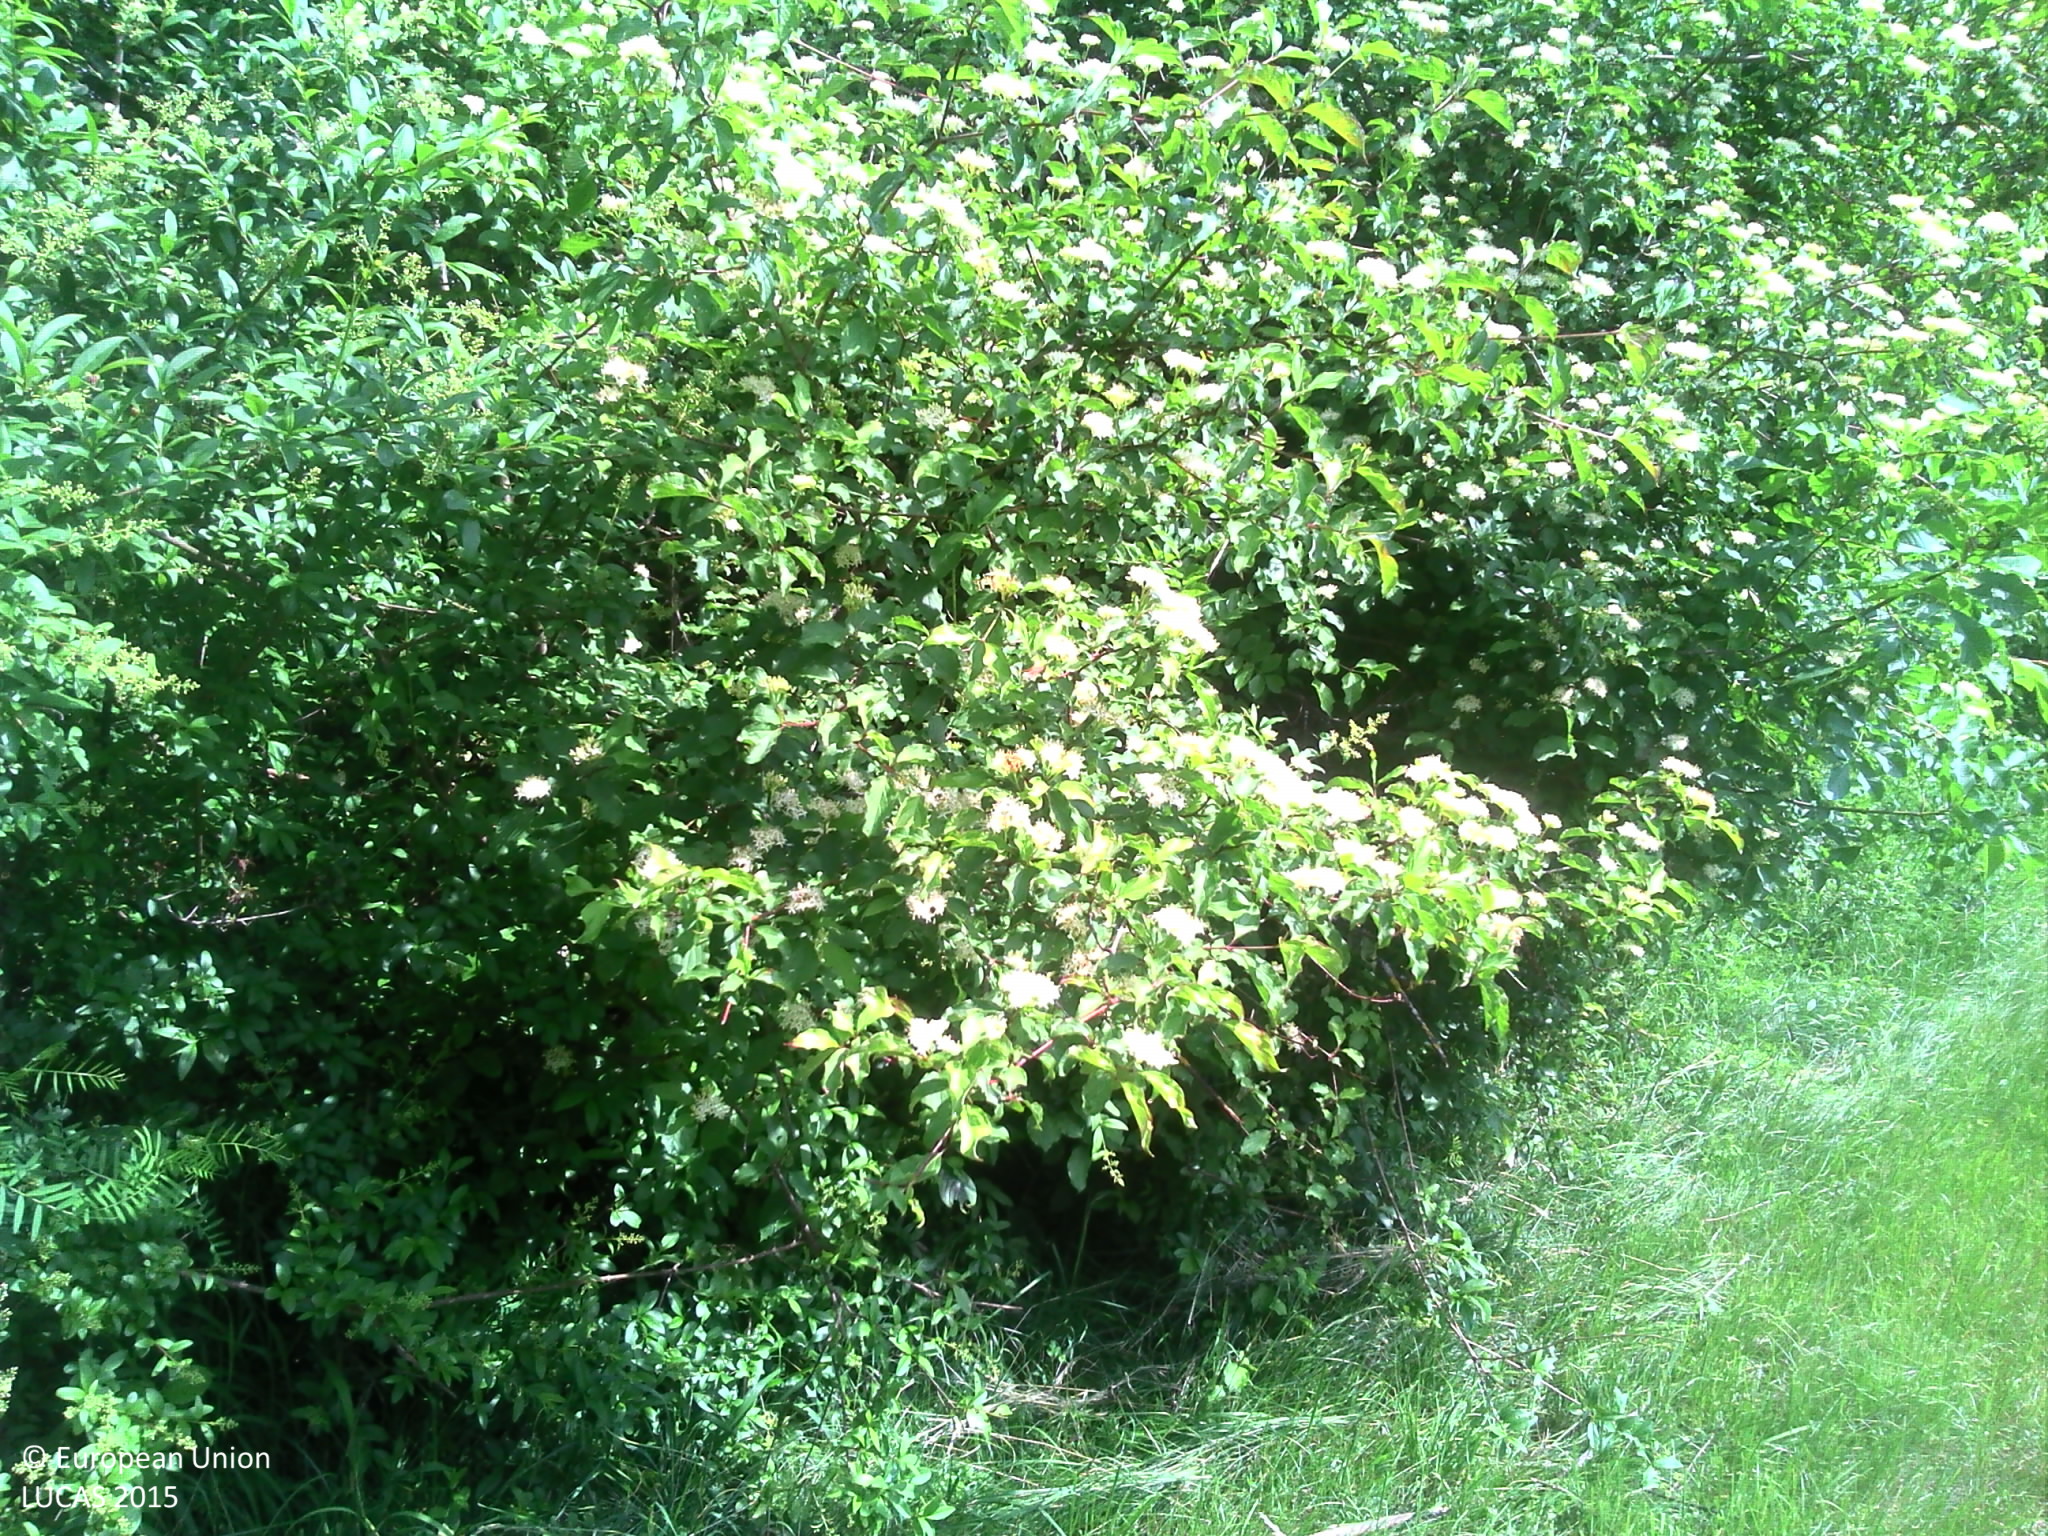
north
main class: Woodland
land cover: Broadleaved woodland
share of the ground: > 75 %
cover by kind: broadleaved forest trees 100 %
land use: Forestry
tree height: < 5 m
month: May
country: FR
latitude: 48.6630
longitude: 7.4890
